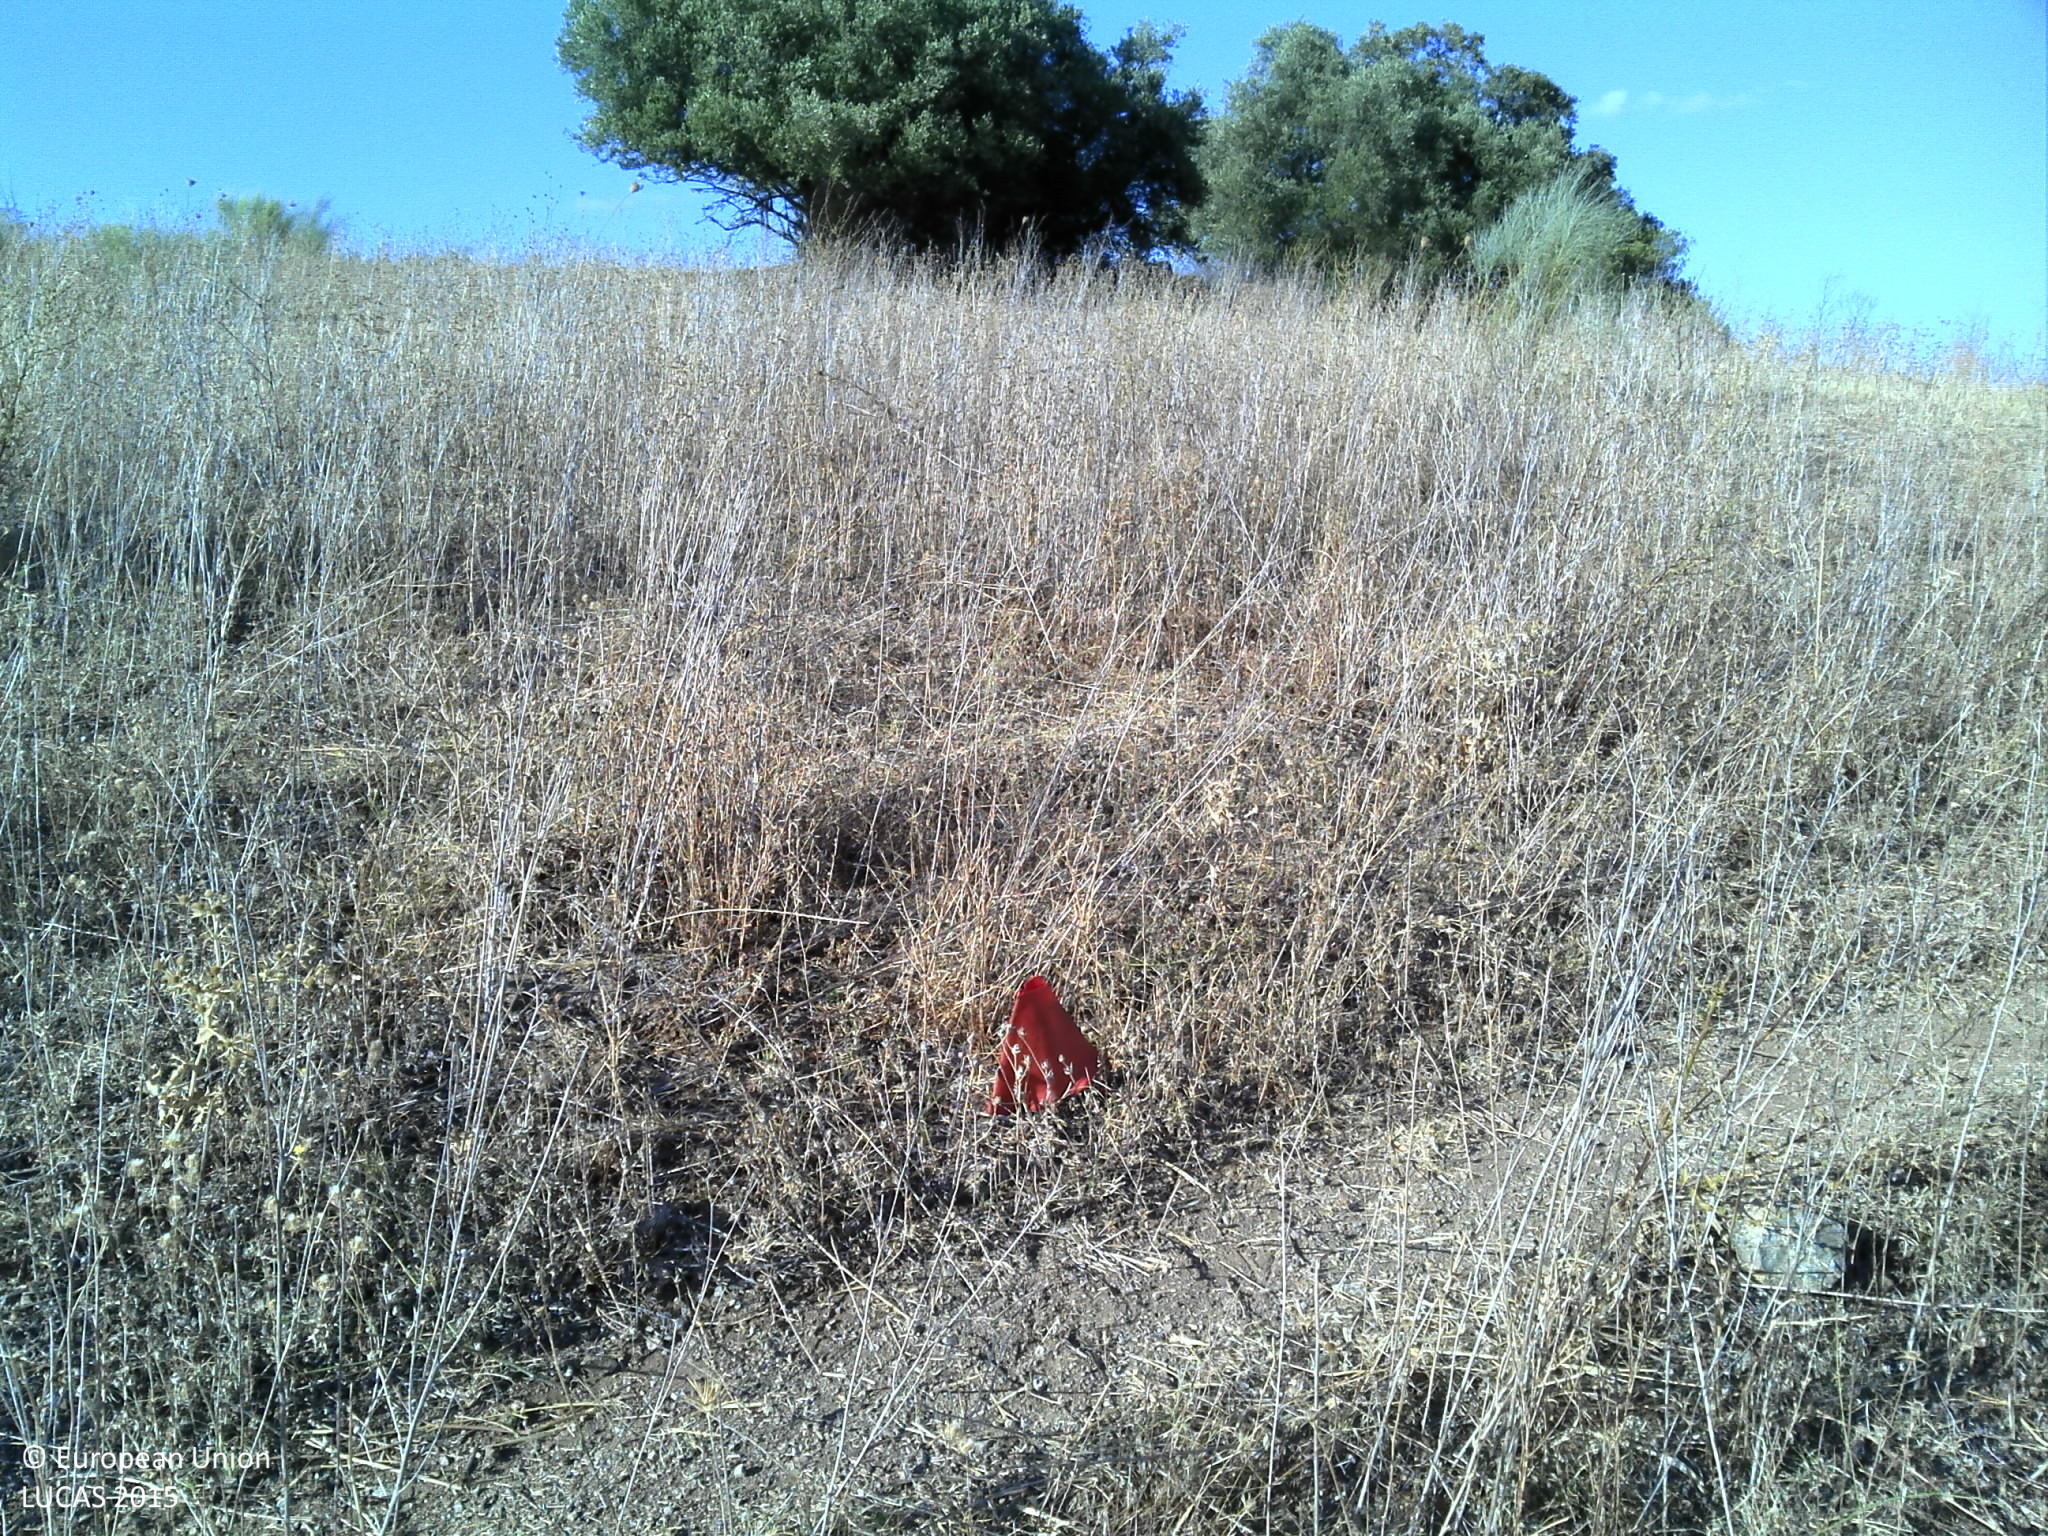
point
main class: Grassland
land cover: Grassland with sparse tree/shrub cover
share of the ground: 25 - 50 %
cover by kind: herbaceous plants 90 %, broadleaved forest trees 5 %, unconsolidated bare surface 5 %
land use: Agriculture (excluding fallow land and kitchen gardens)
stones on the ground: < 10 %
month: July
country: PT
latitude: 37.9113
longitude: -7.6625
